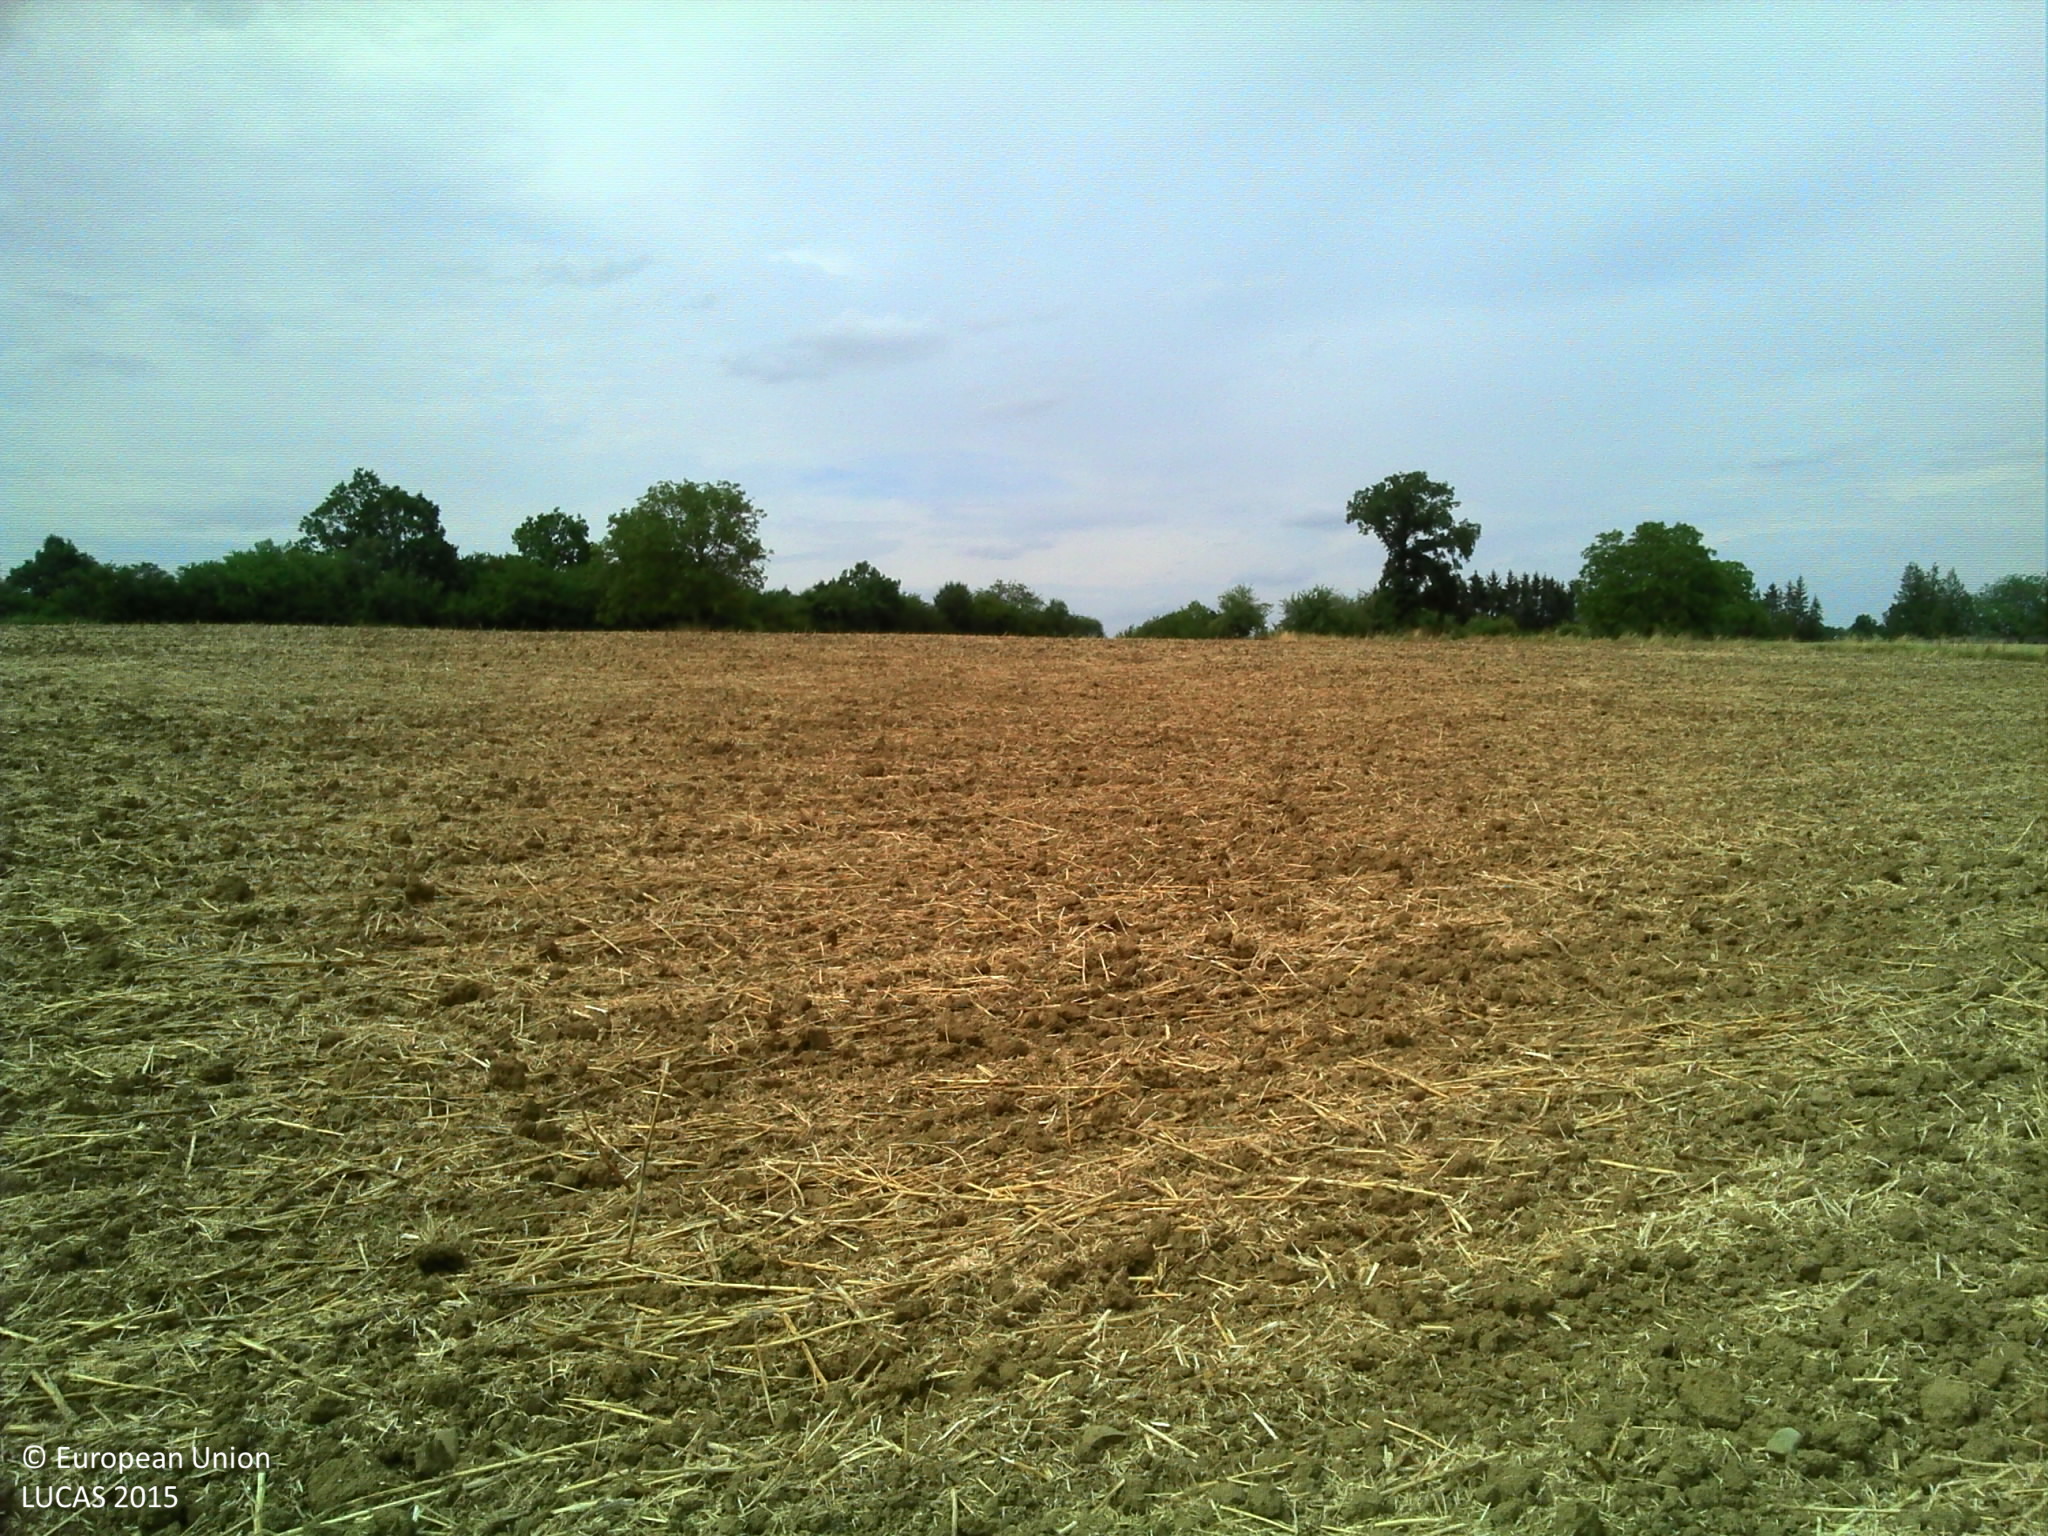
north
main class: Cropland
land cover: Rape and turnip rape
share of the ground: > 75 %
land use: Agriculture (excluding fallow land and kitchen gardens)
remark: Harvested field
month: July
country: FR
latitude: 48.3896
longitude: 6.1245
